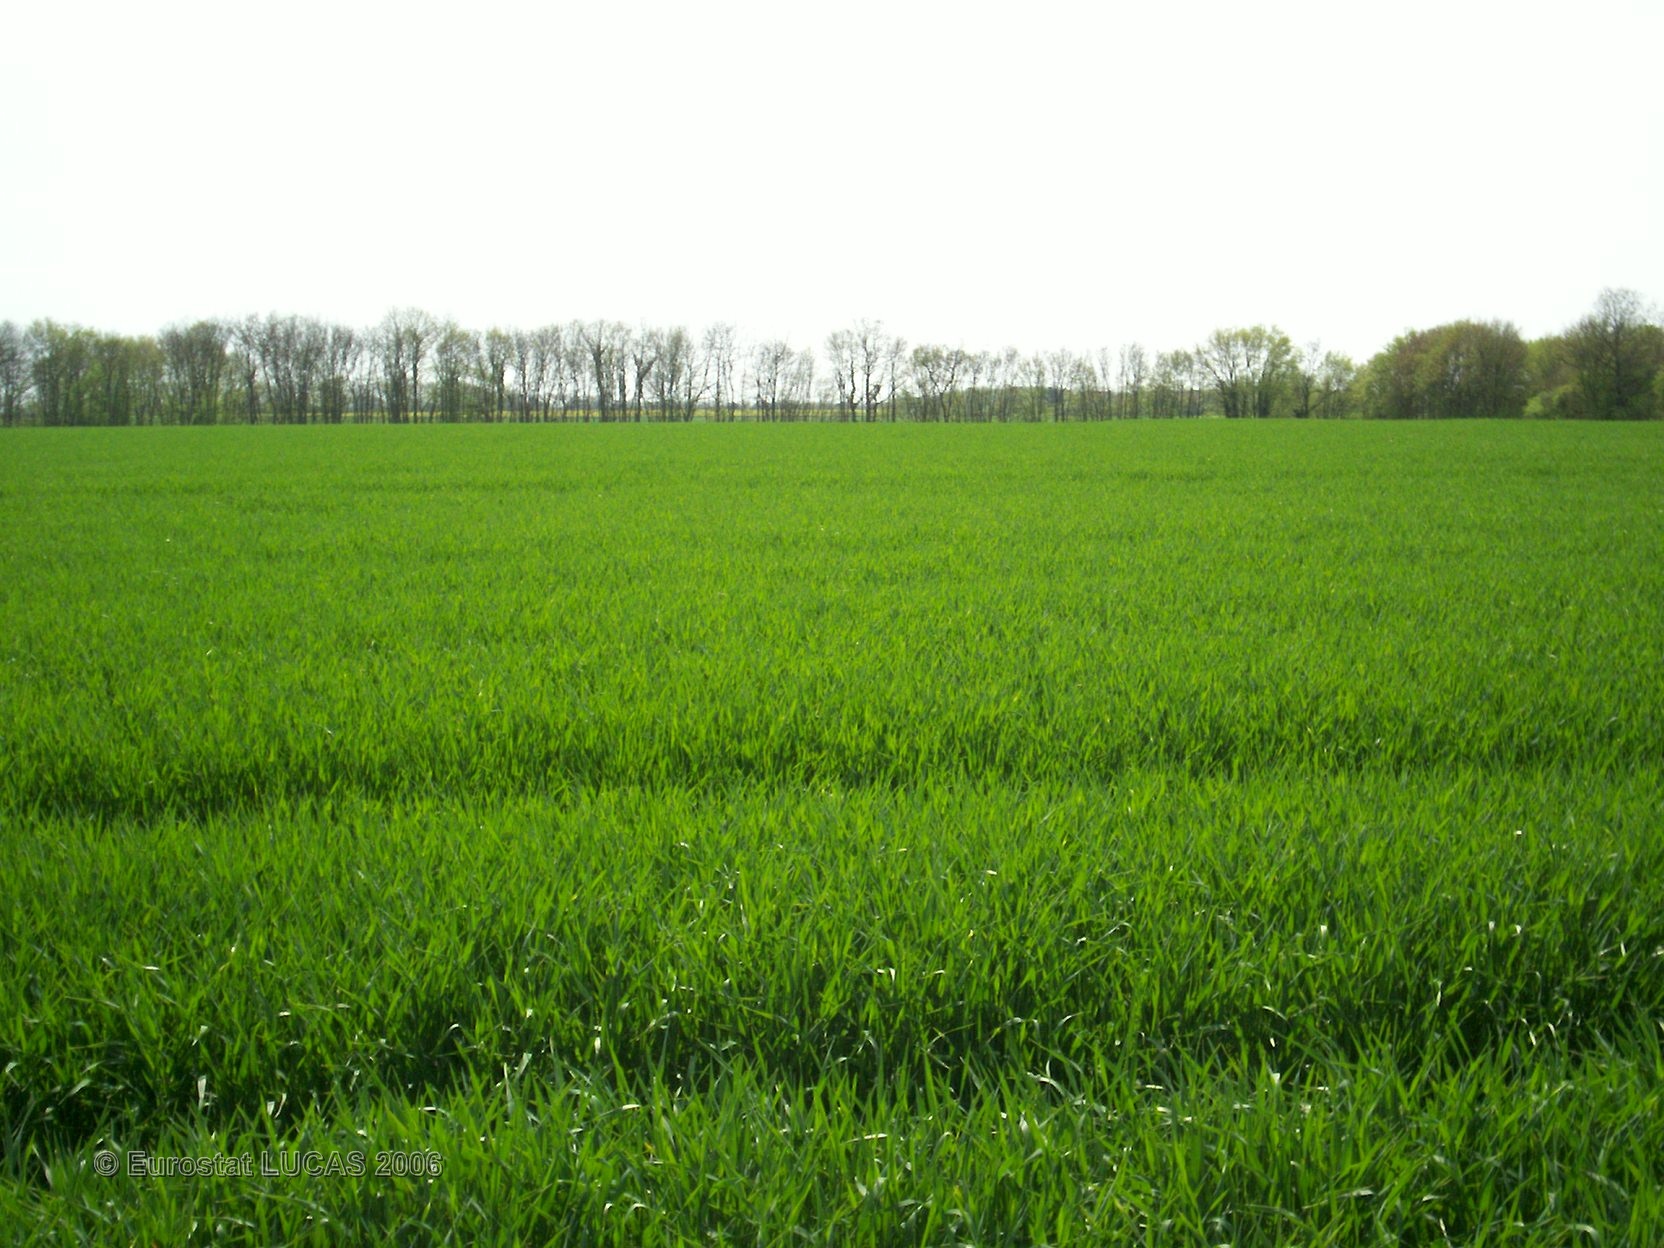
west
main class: Cropland
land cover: Barley
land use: Agriculture (excluding fallow land and kitchen gardens)
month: May
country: FR
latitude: 47.8521
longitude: 4.5055
